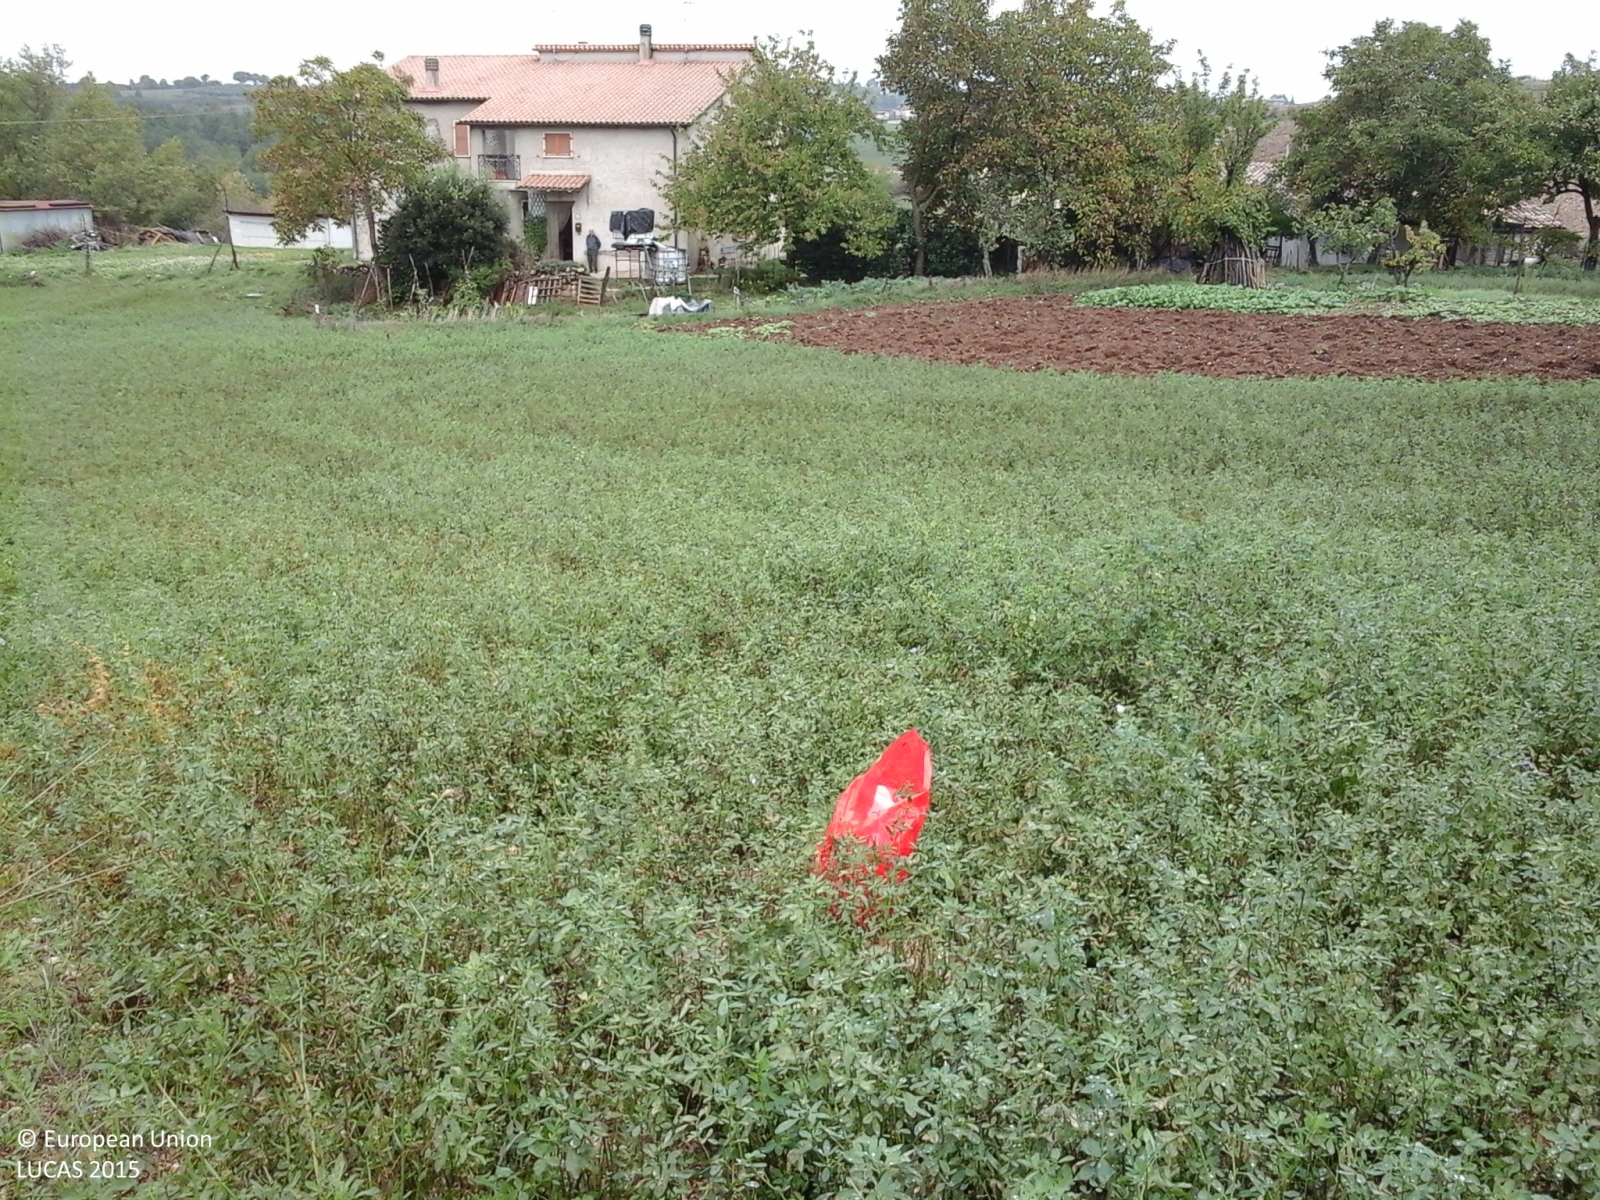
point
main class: Cropland
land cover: Clovers
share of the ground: > 75 %
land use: Agriculture (excluding fallow land and kitchen gardens)
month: October
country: IT
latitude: 42.6991
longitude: 12.3485
